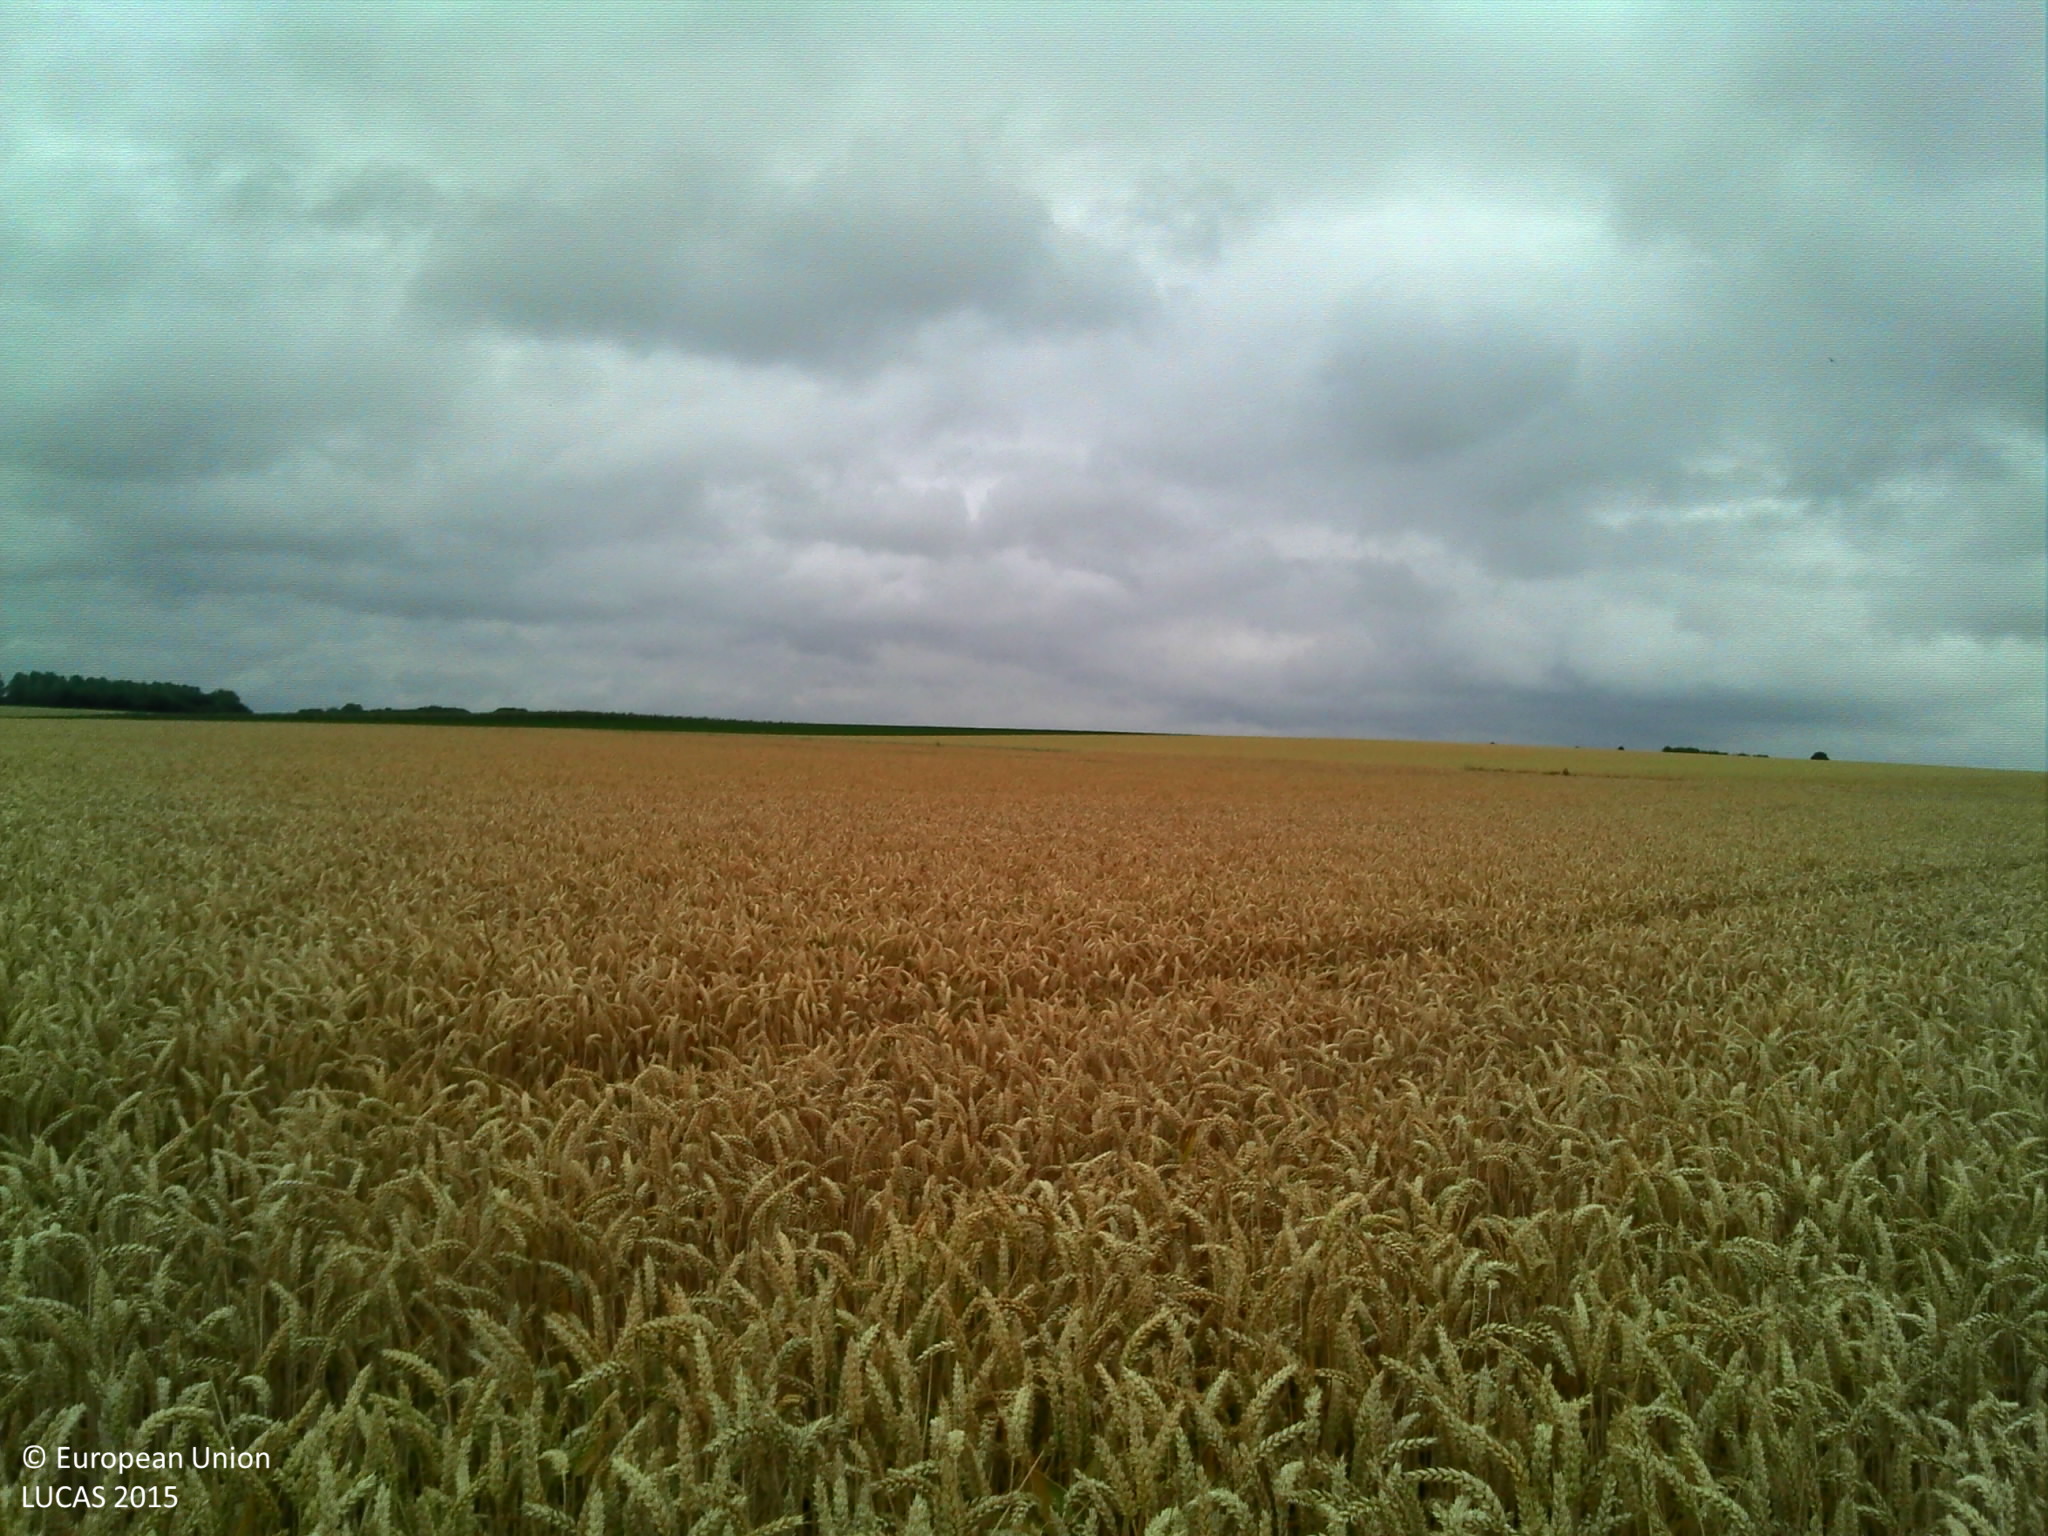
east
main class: Cropland
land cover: Common wheat
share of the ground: > 75 %
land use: Agriculture (excluding fallow land and kitchen gardens)
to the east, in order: Common wheat; Grass margins; Paved roads, cycling and walking lanes; Grass margins; Common wheat
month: July
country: BE
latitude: 50.7817
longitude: 5.1042
